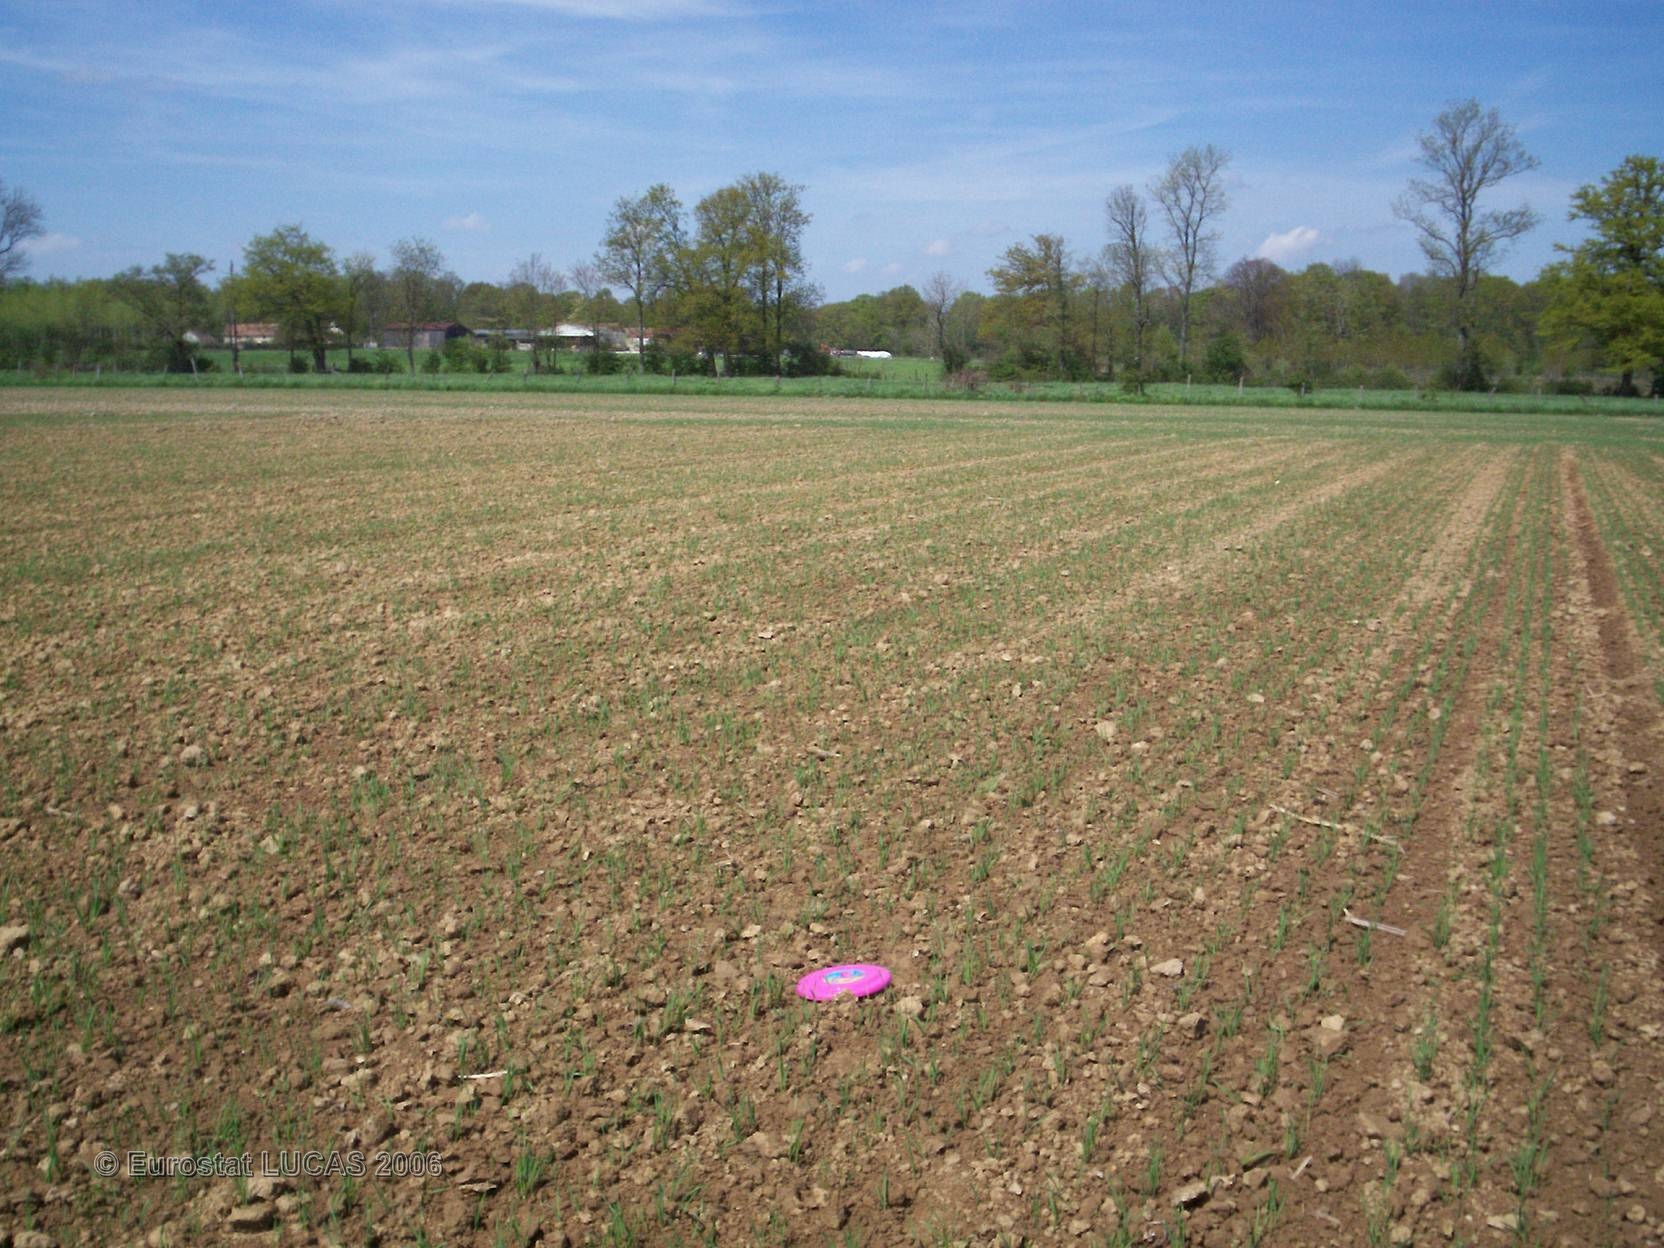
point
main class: Cropland
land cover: Barley
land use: Agriculture (excluding fallow land and kitchen gardens)
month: May
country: FR
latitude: 48.7839
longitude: 2.8181
